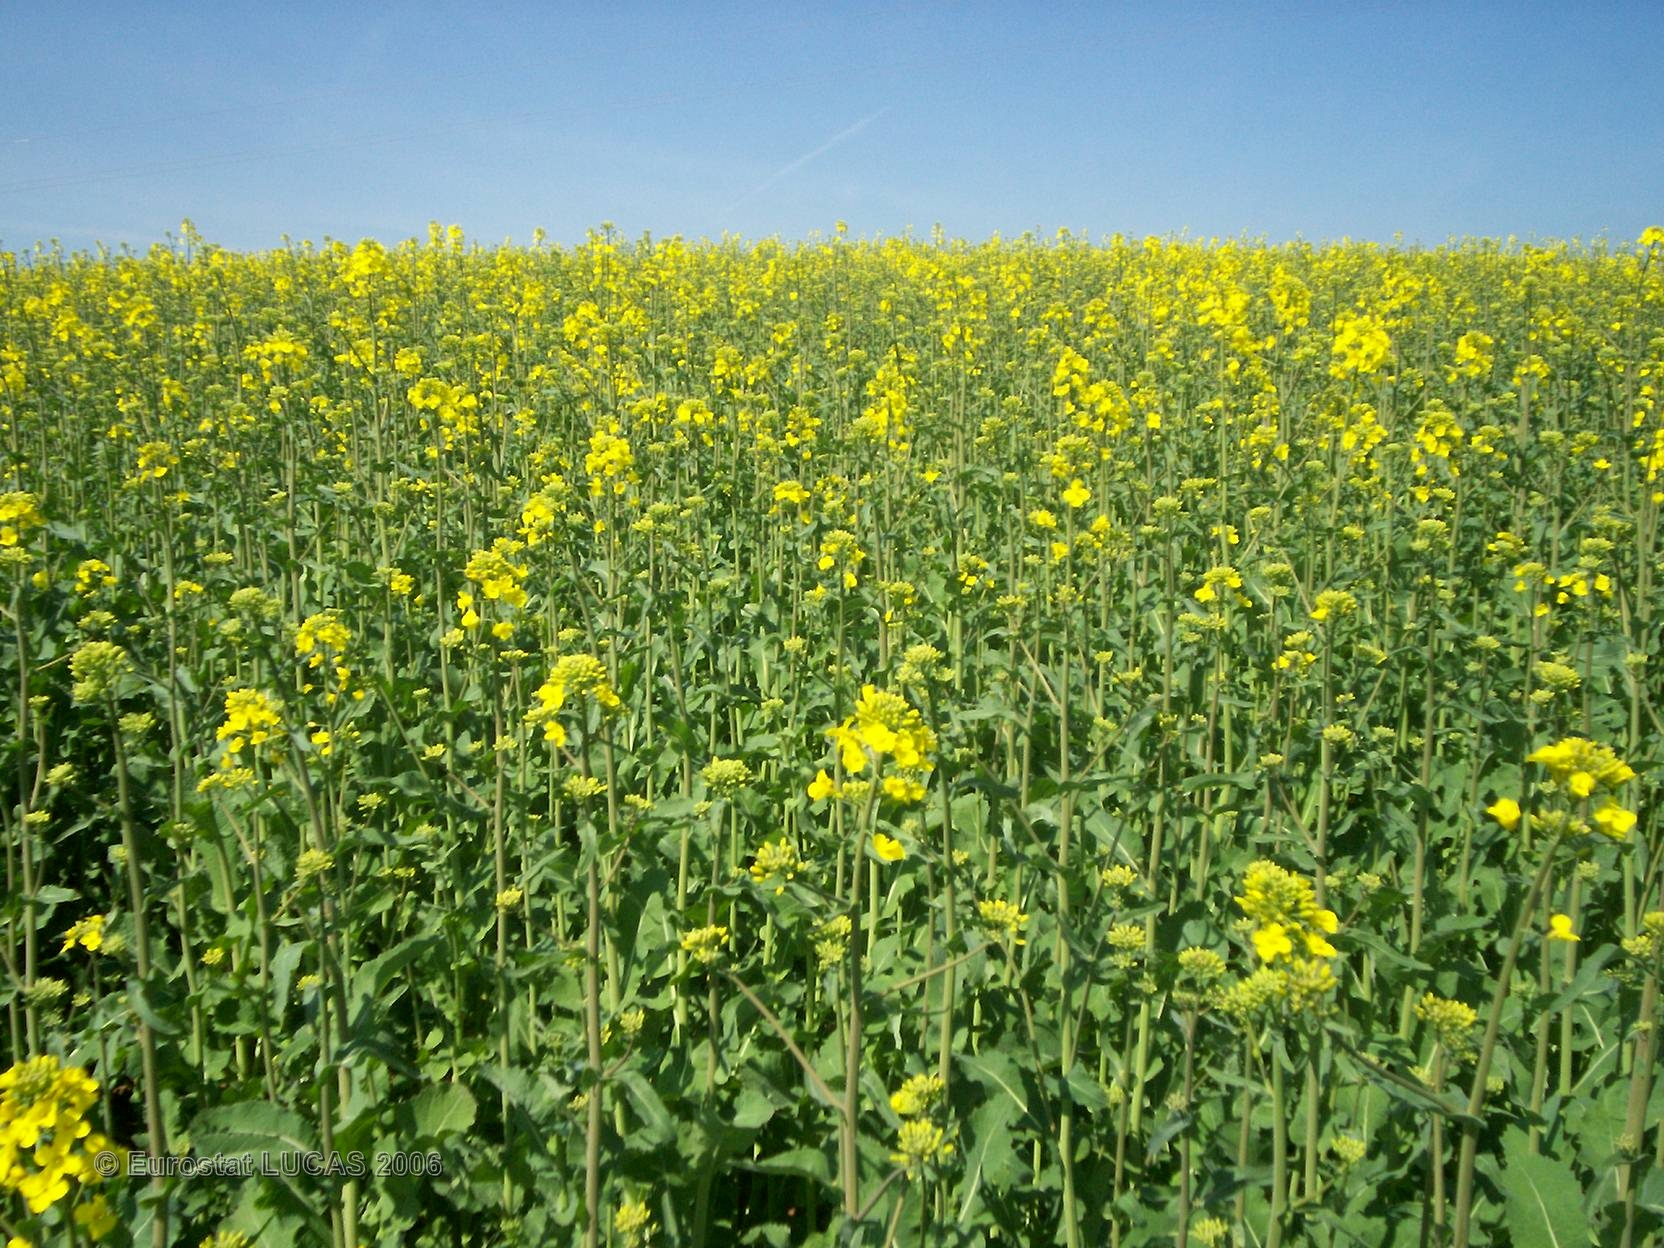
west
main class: Cropland
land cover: Rape and turnip rape
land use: Agriculture (excluding fallow land and kitchen gardens)
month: April
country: FR
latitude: 45.4678
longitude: 4.8242
